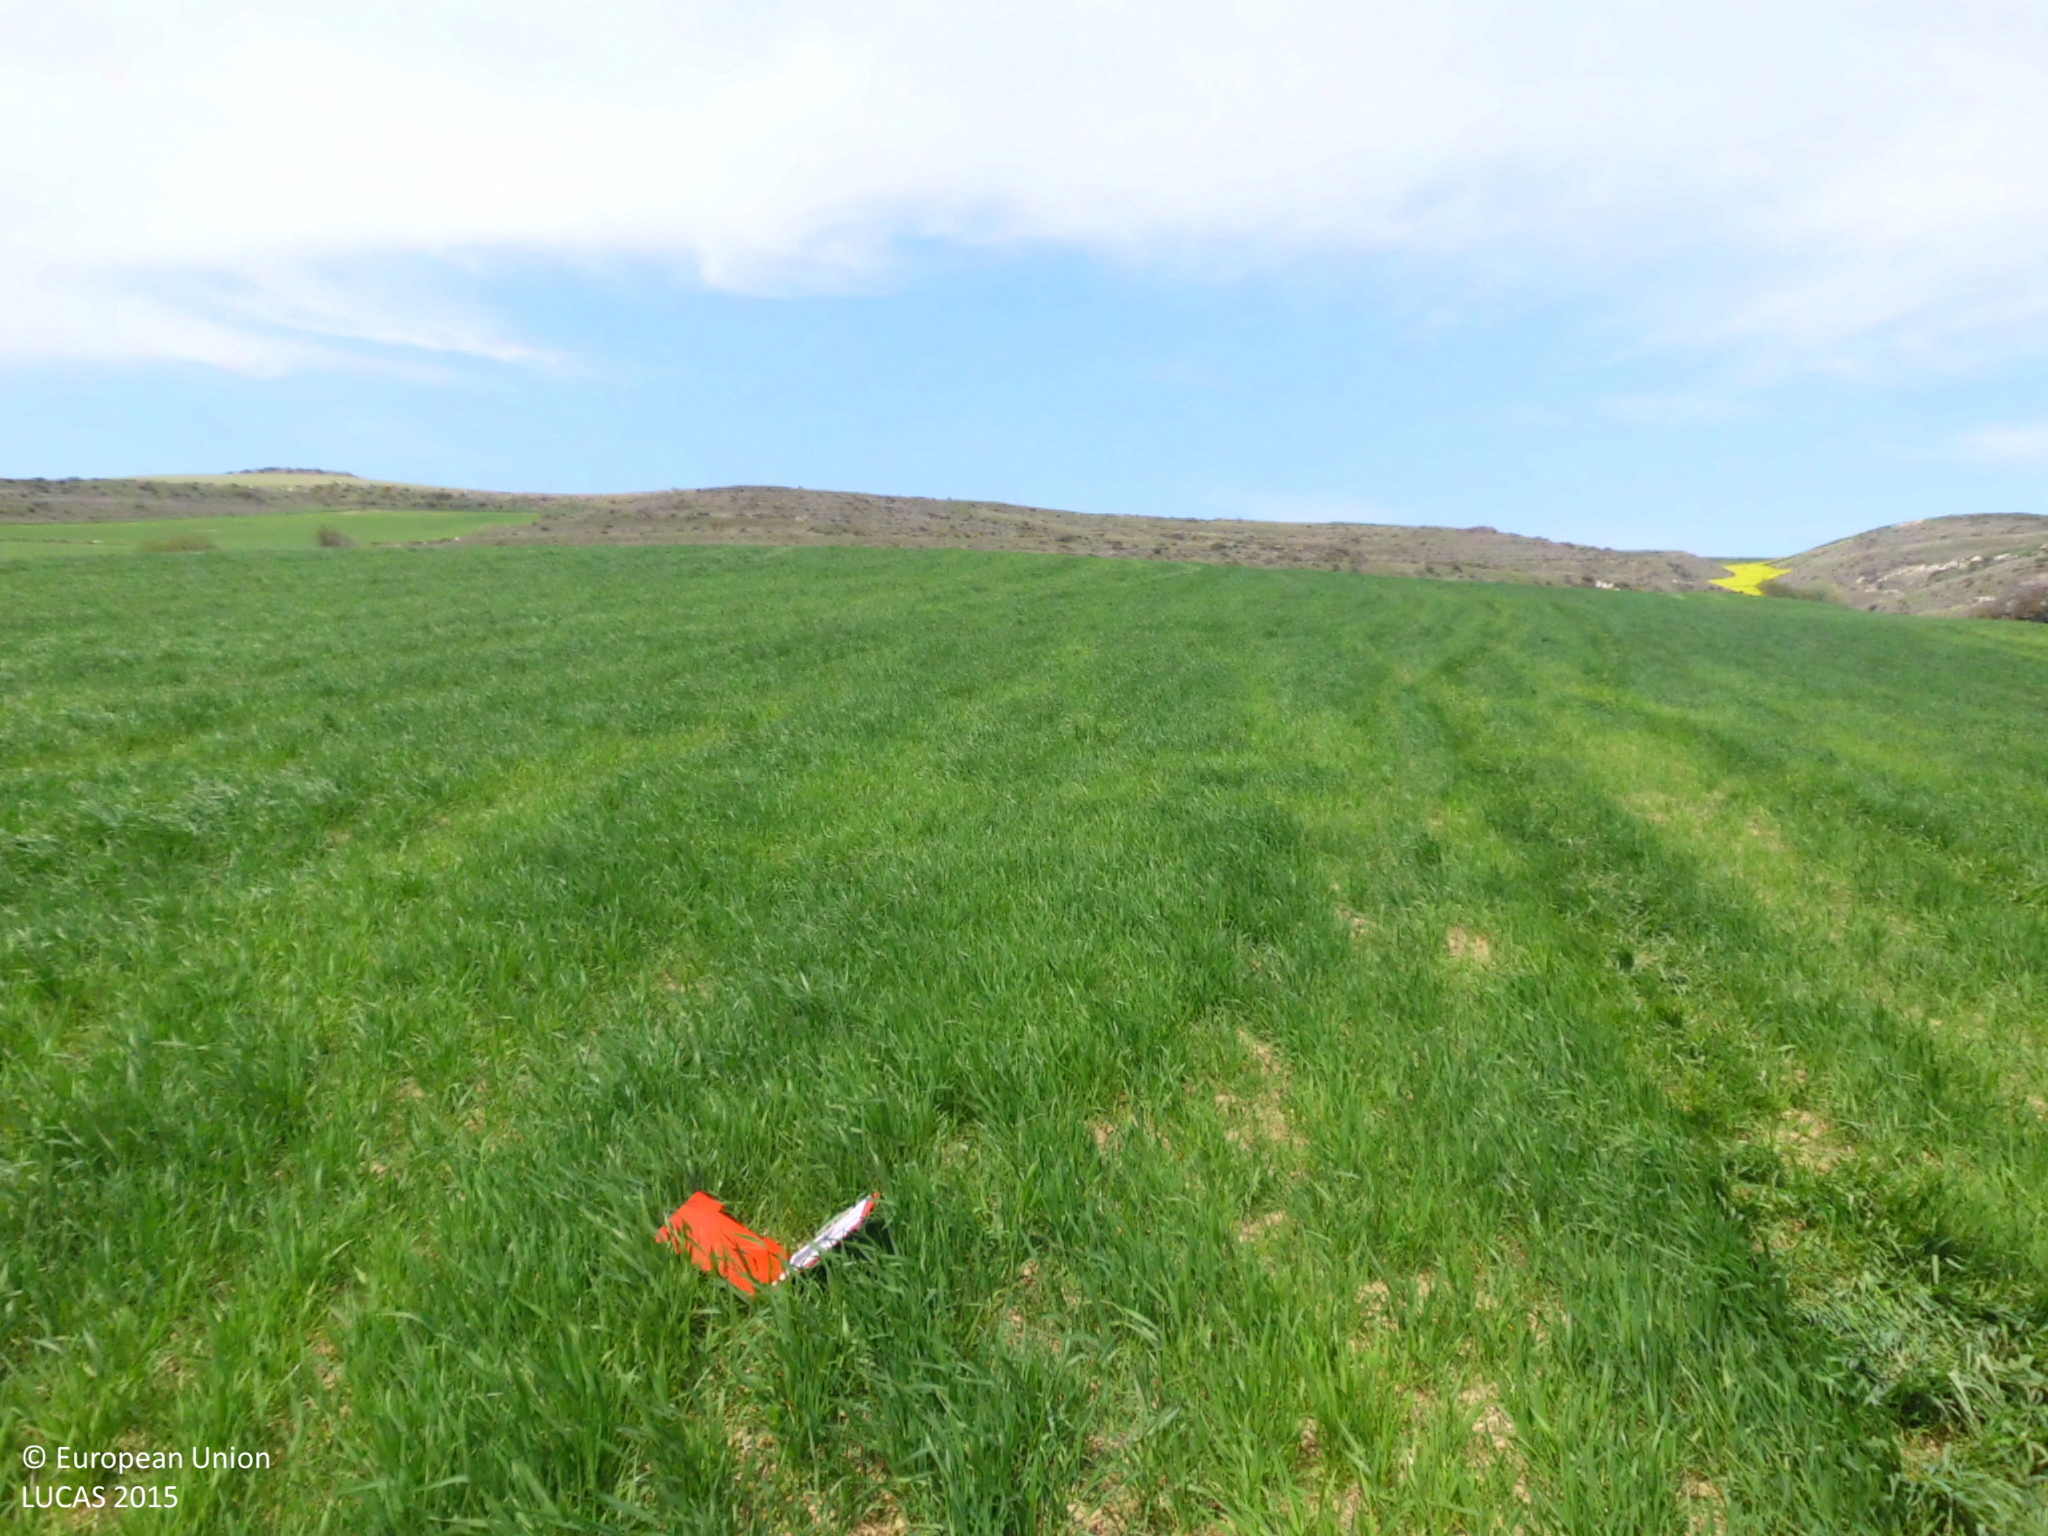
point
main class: Cropland
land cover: Barley
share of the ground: > 75 %
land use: Agriculture (excluding fallow land and kitchen gardens)
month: April
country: ES
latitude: 42.4138
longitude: -3.2886
